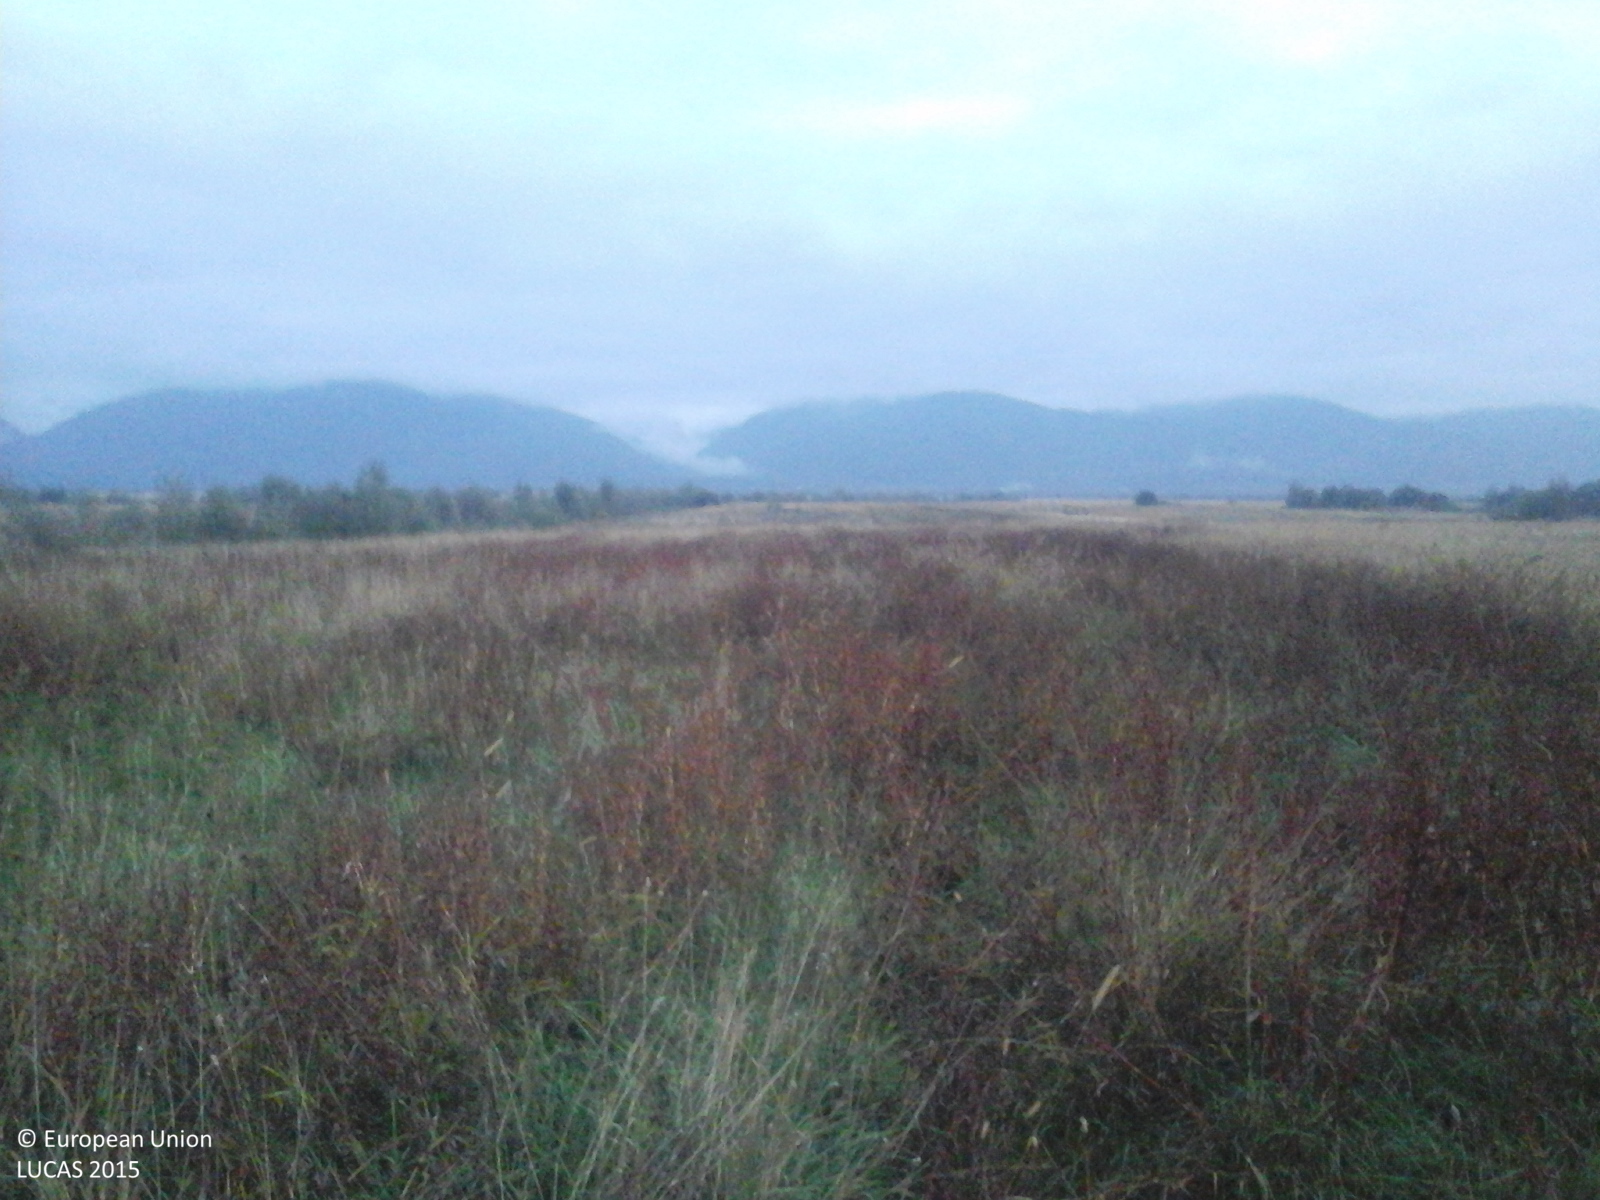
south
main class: Grassland
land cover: Grassland without tree/shrub cover
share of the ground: > 75 %
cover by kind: herbaceous plants 100 %
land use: Agriculture (excluding fallow land and kitchen gardens)
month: October
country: RO
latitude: 45.7352
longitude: 24.8022
